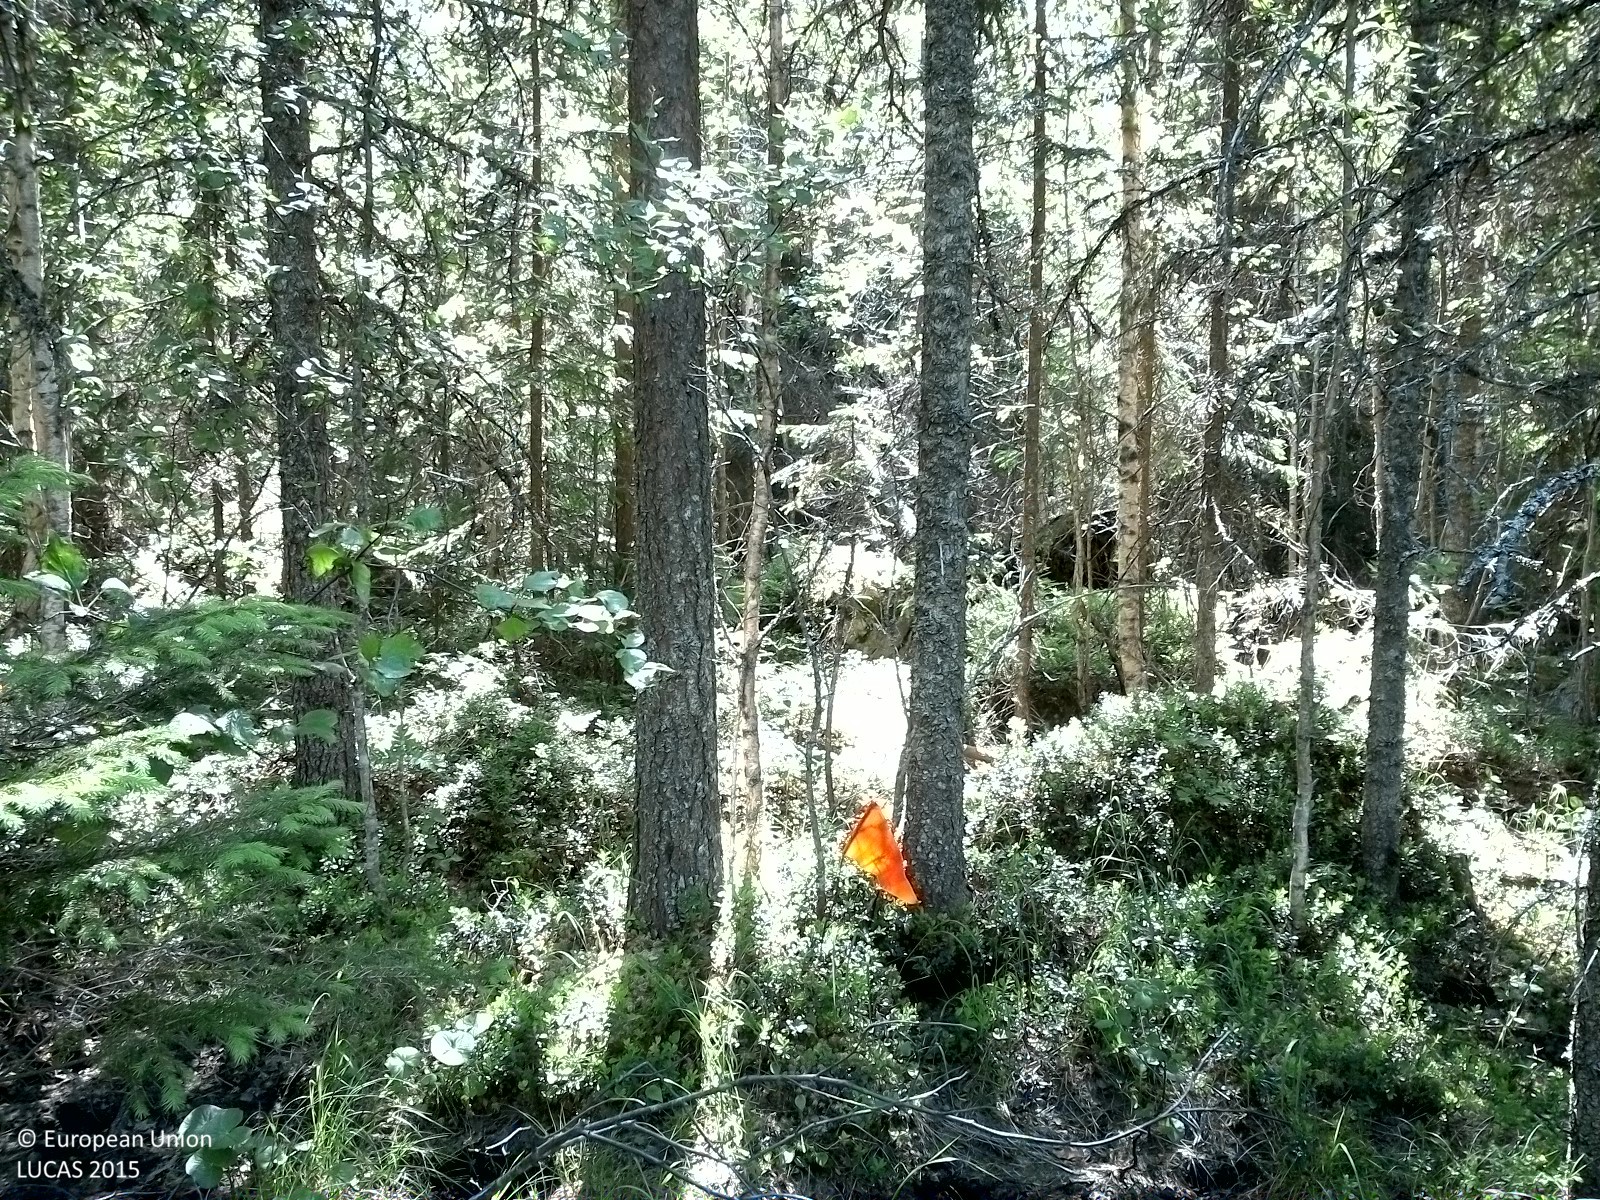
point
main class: Woodland
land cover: Spruce dominated mixed woodland
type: boreal forest
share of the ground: 50 - 75 %
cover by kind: coniferous forest trees 45 %, shrubs 30 %, broadleaved forest trees 15 %, herbaceous plants 10 %
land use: Forestry
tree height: > 5 m
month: July
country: SE
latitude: 62.2535
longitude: 16.9314
